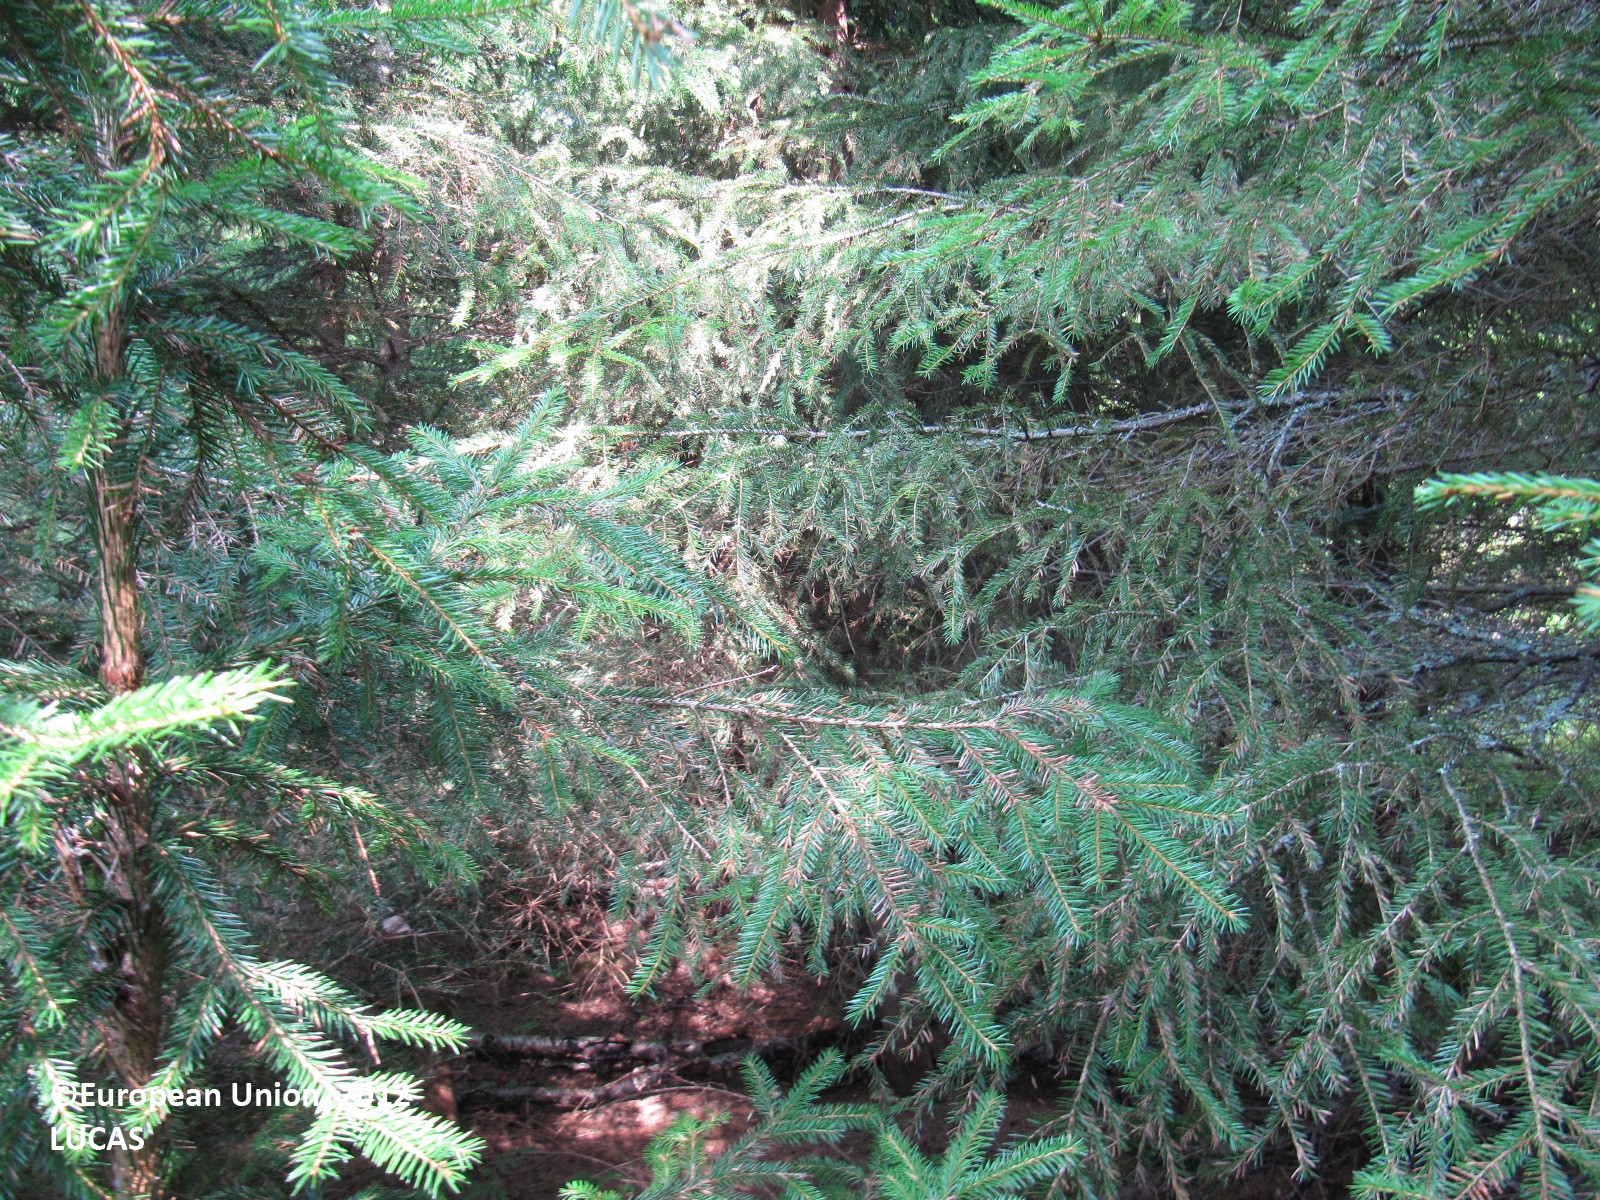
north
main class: Woodland
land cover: Spruce dominated coniferous woodland
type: boreal forest
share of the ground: > 75 %
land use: Forestry
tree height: > 5 m
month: August
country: FI
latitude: 61.1709
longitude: 22.9561
